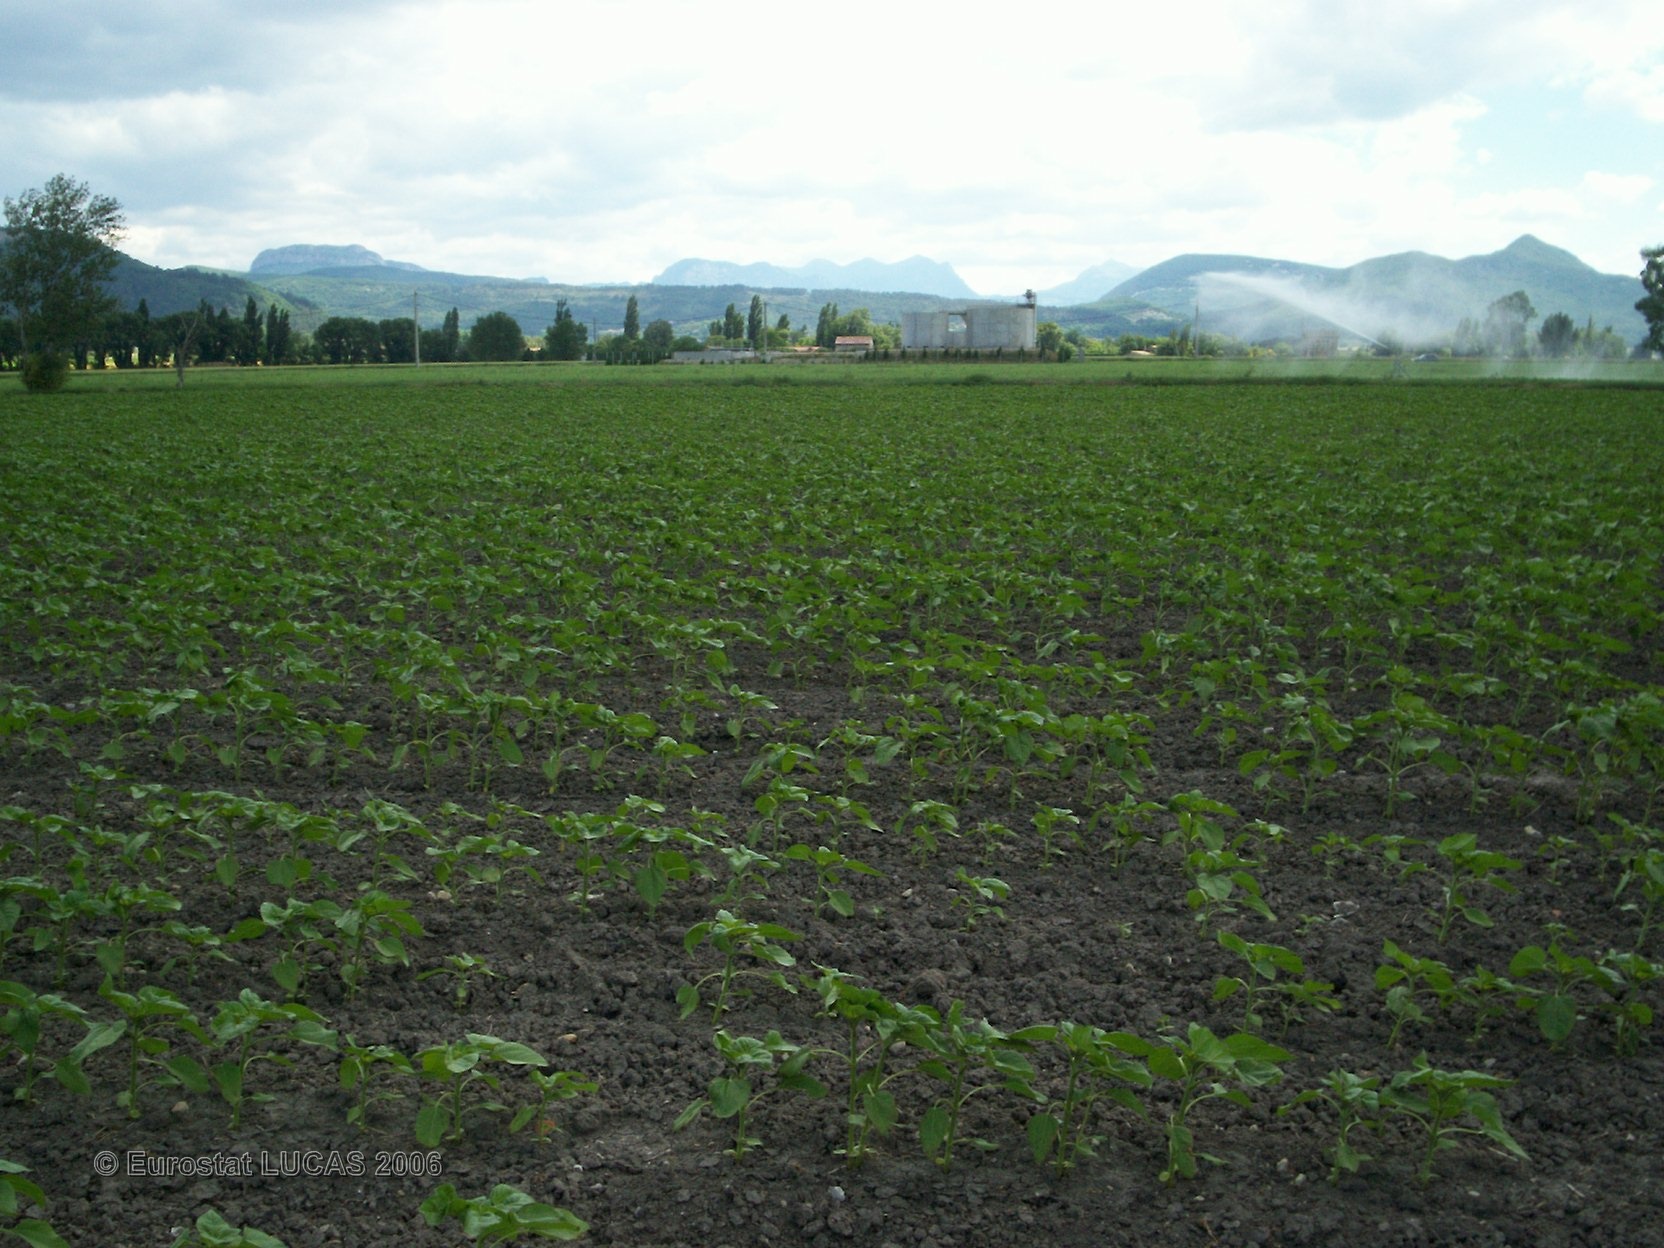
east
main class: Cropland
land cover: Durum wheat
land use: Agriculture (excluding fallow land and kitchen gardens)
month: May
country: FR
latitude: 44.6240
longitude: 4.9273
